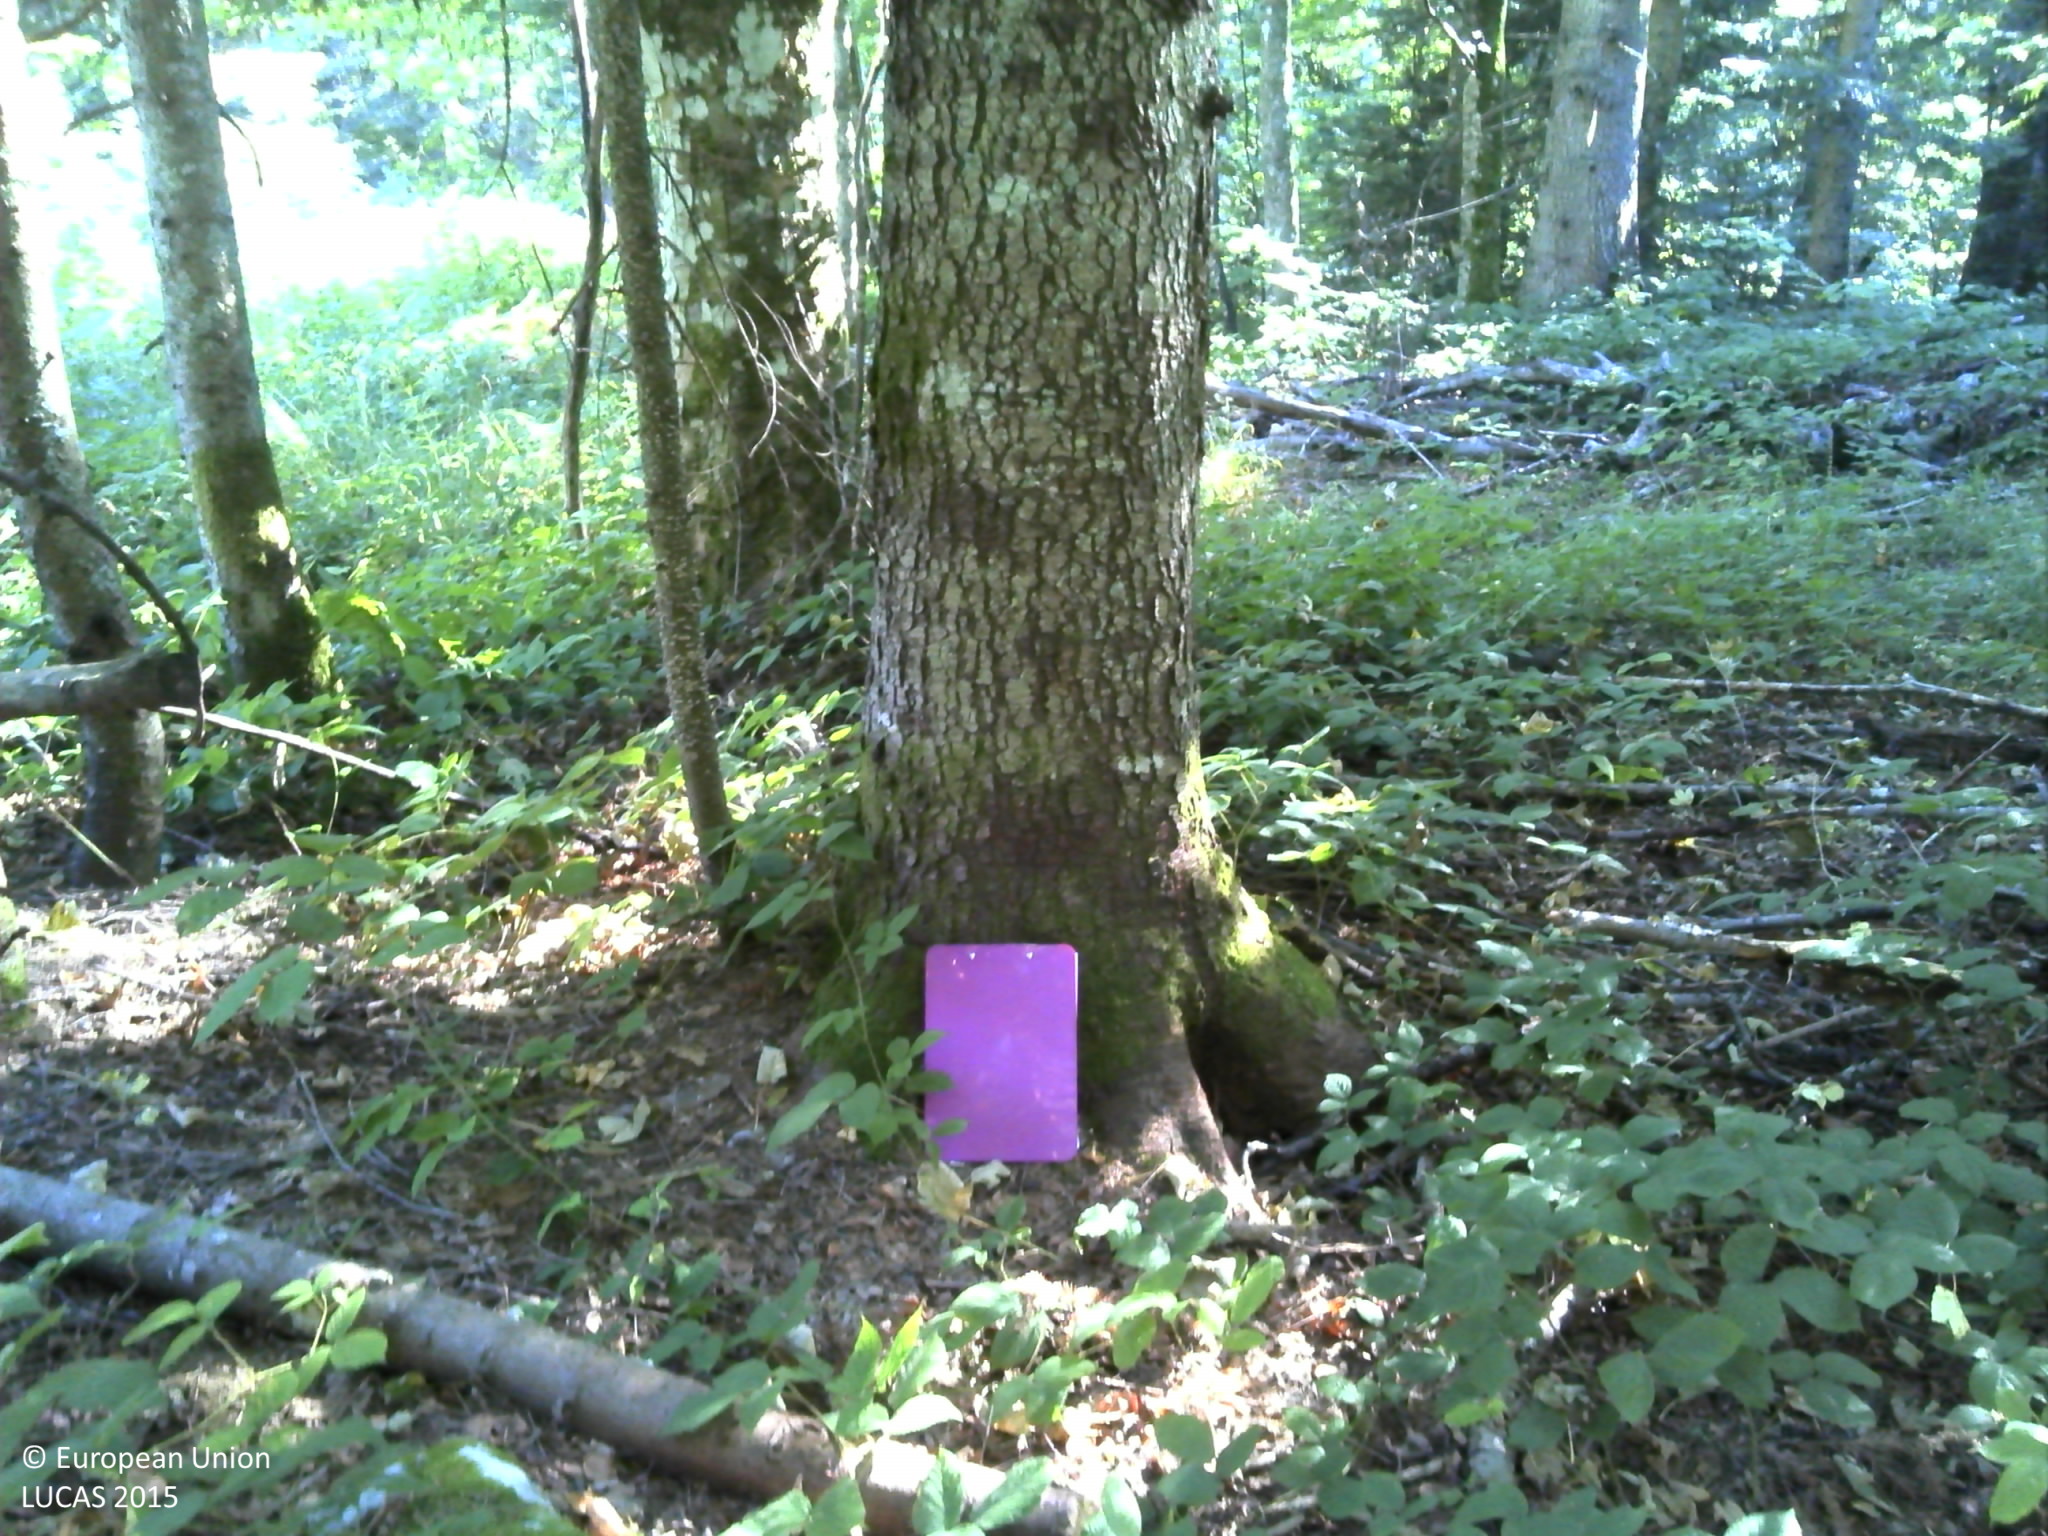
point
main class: Woodland
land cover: Pine dominated coniferous woodland
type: coniferous forest of the mediterranean region
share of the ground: > 75 %
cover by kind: coniferous forest trees 100 %
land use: Forestry
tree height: > 5 m
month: August
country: HR
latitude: 45.1070
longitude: 15.1676
